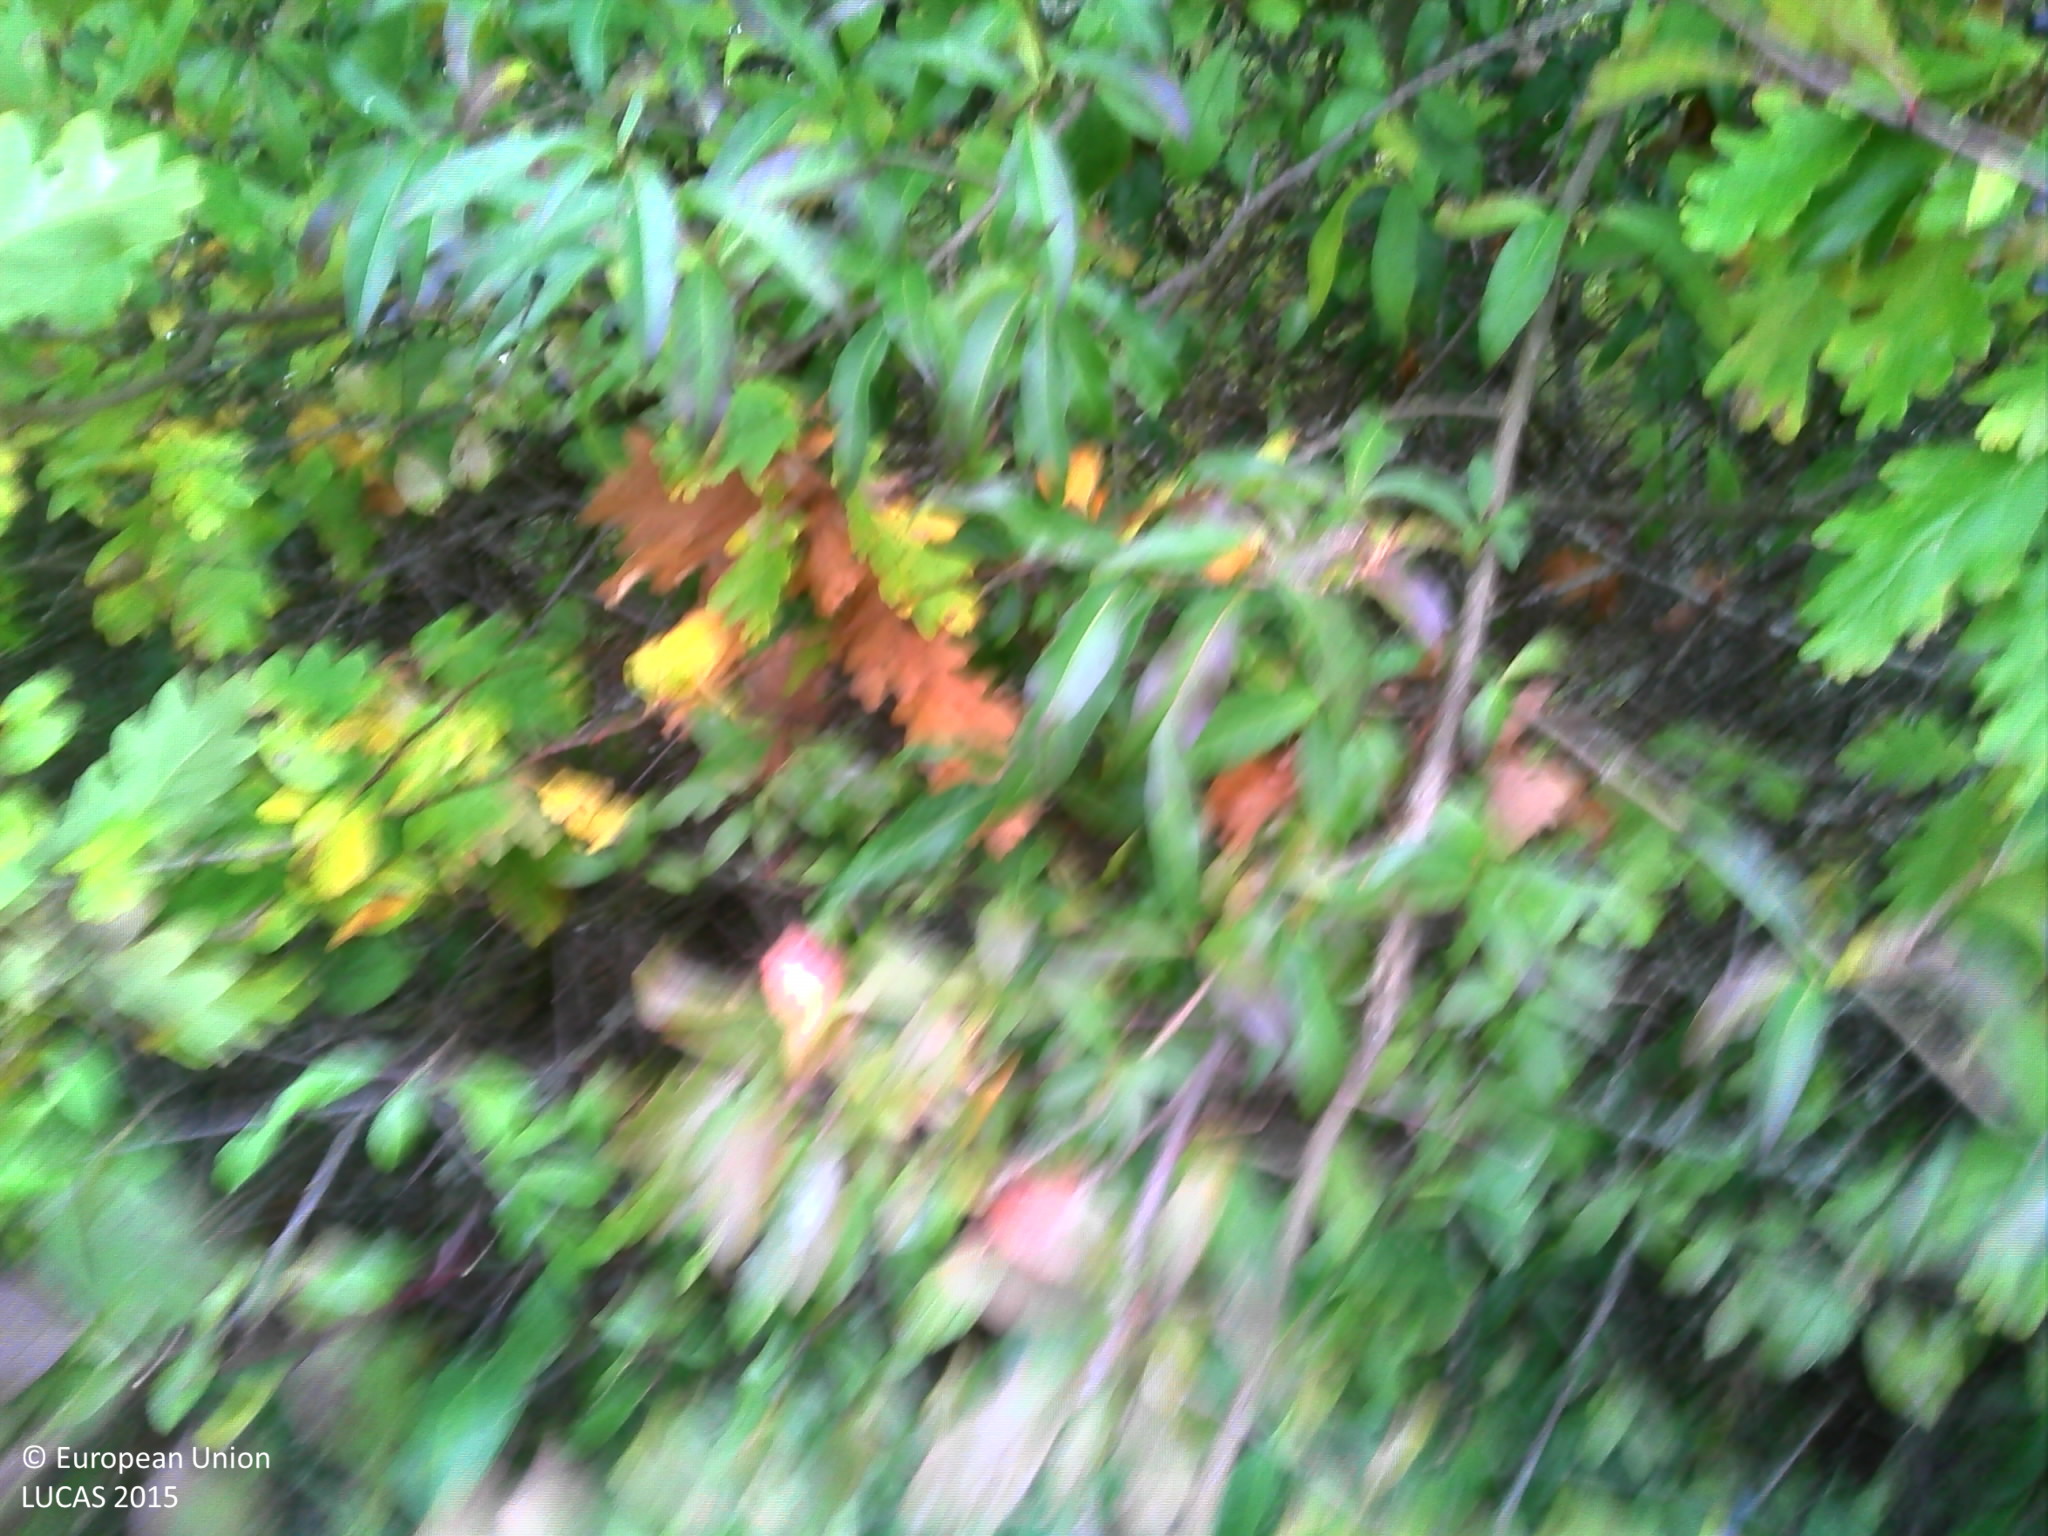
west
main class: Woodland
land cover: Broadleaved woodland
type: mesophytic deciduous forest
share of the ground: > 75 %
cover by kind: broadleaved forest trees 100 %
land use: Semi-natural and natural areas not in use
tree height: > 5 m
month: October
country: FR
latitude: 47.4585
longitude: 4.9462
